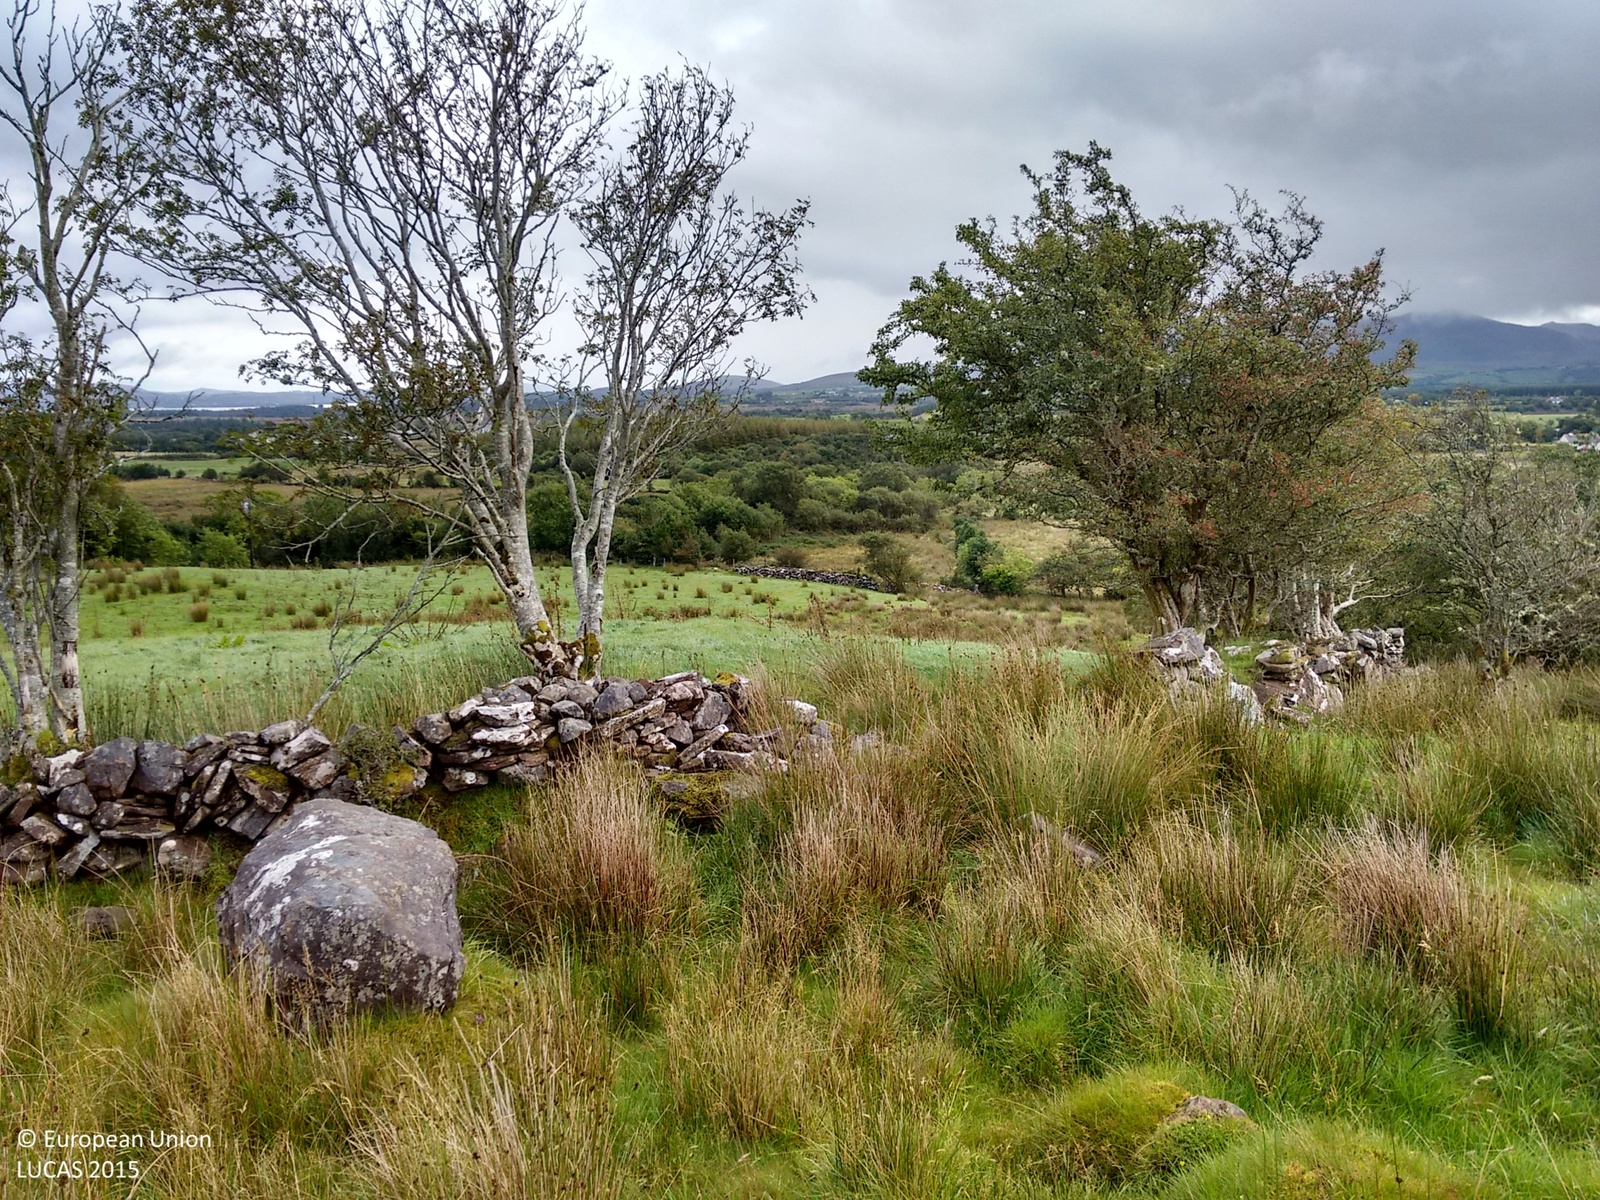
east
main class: Shrubland
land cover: Shrubland without tree cover
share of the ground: > 75 %
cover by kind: shrubs 60 %, lichens and mosses 30 %, herbaceous plants 10 %
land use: Agriculture (excluding fallow land and kitchen gardens)
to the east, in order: Shrubland without tree cover; Fences; Shrubland without tree cover
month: September
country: IE
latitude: 54.0064
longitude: -9.3436
